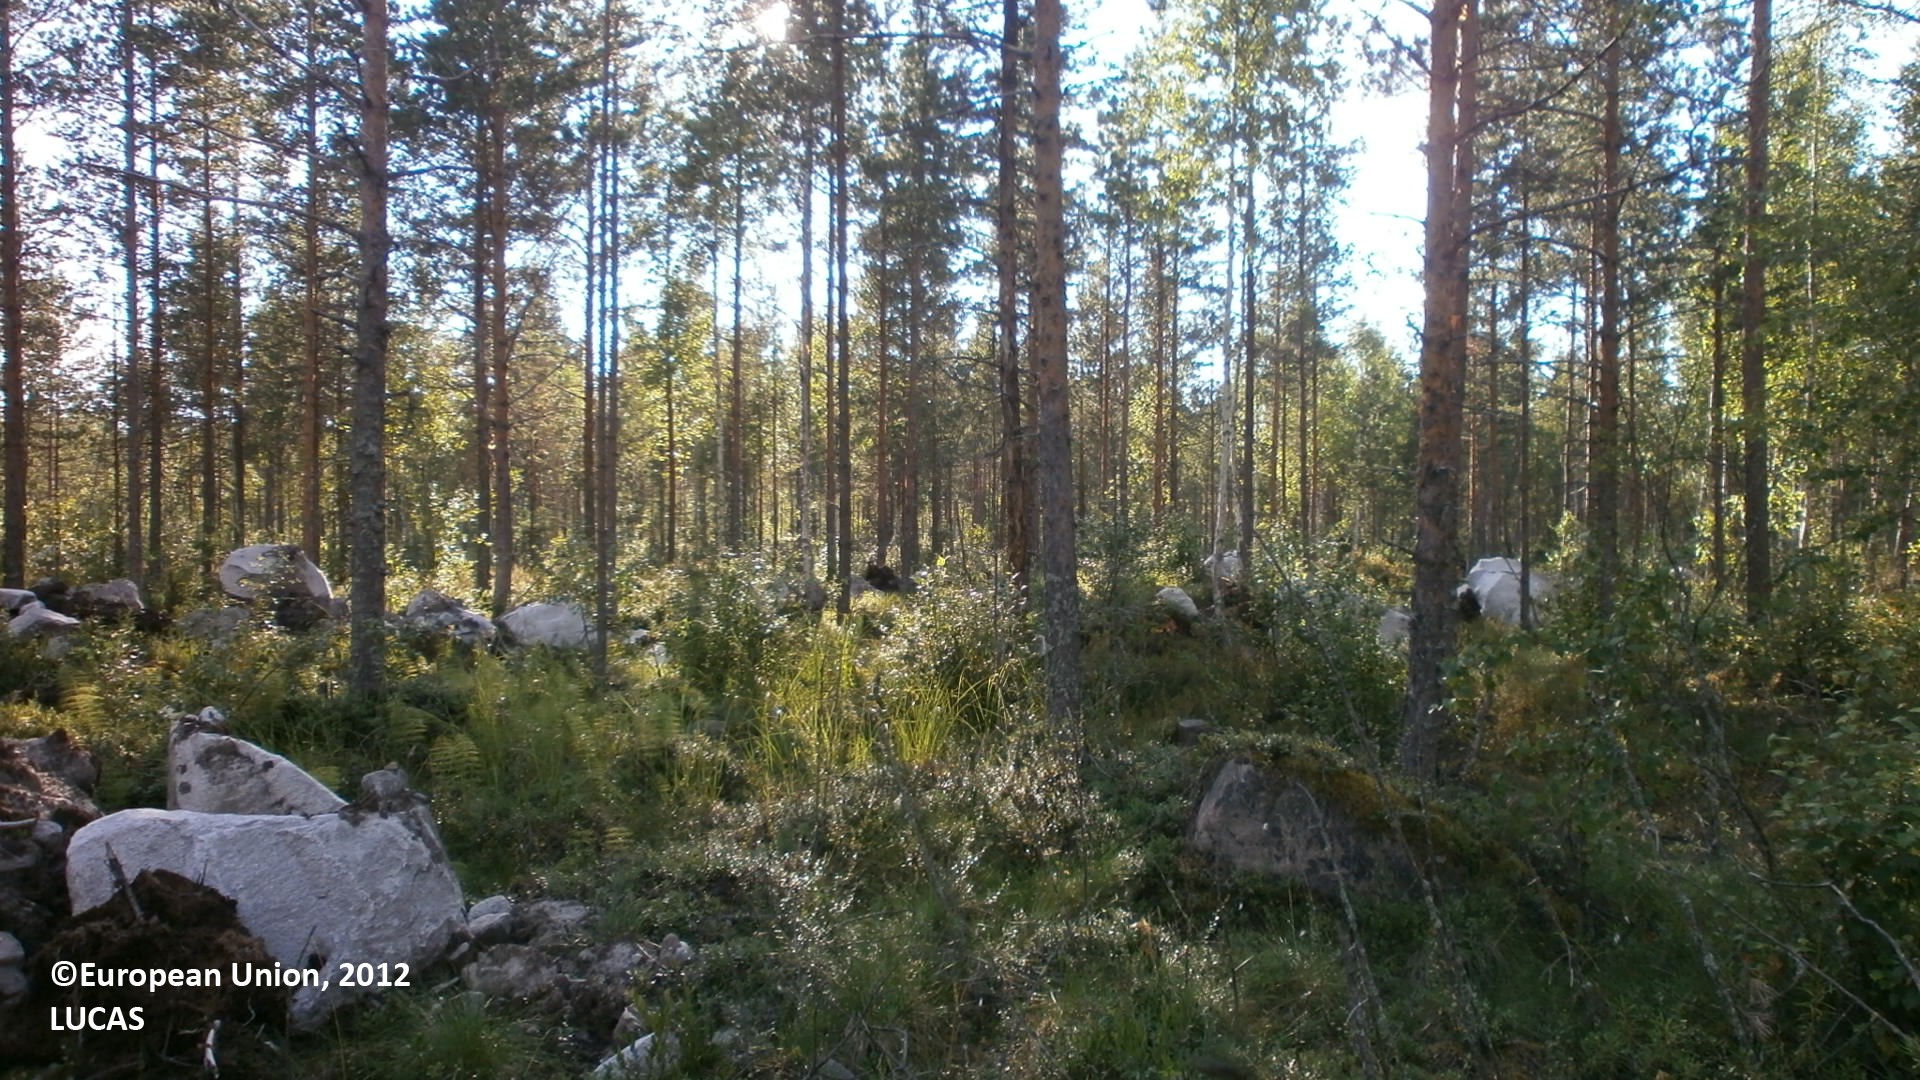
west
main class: Woodland
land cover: Pine dominated coniferous woodland
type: mire and swamp forests
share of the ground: 50 - 75 %
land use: Forestry
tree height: > 5 m
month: July
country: FI
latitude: 64.0971
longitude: 24.2879
